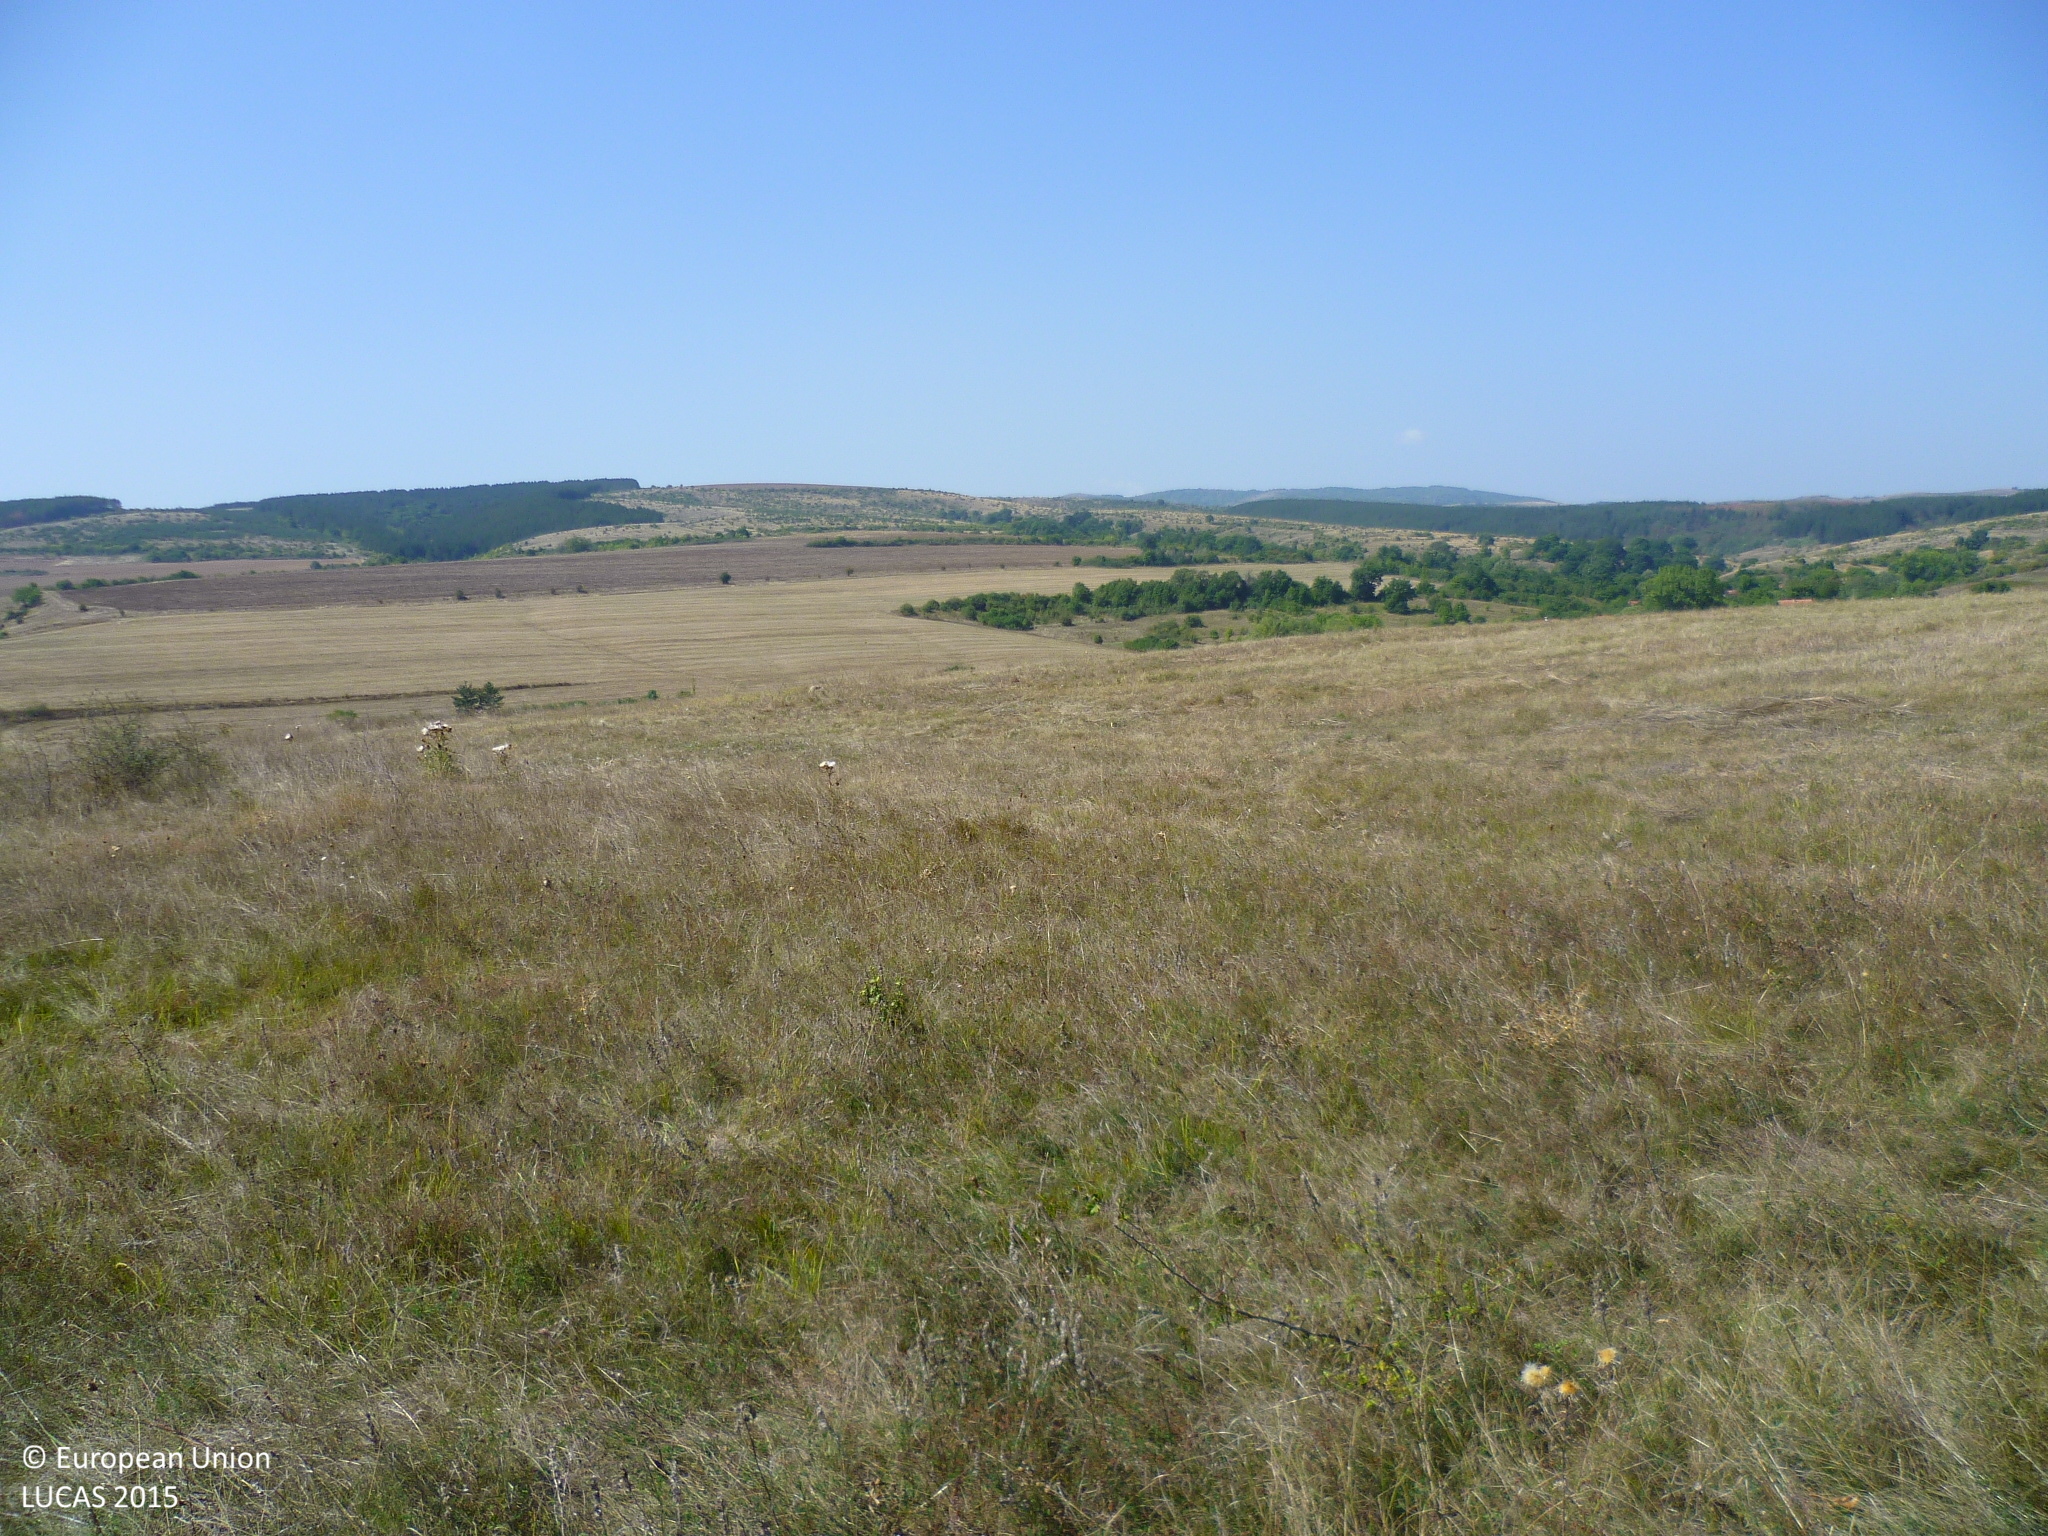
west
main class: Grassland
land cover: Grassland with sparse tree/shrub cover
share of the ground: > 75 %
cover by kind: herbaceous plants 90 %, broadleaved forest trees 5 %, shrubs 5 %
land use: Agriculture (excluding fallow land and kitchen gardens)
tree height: < 5 m
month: September
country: BG
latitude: 42.6060
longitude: 22.9363
